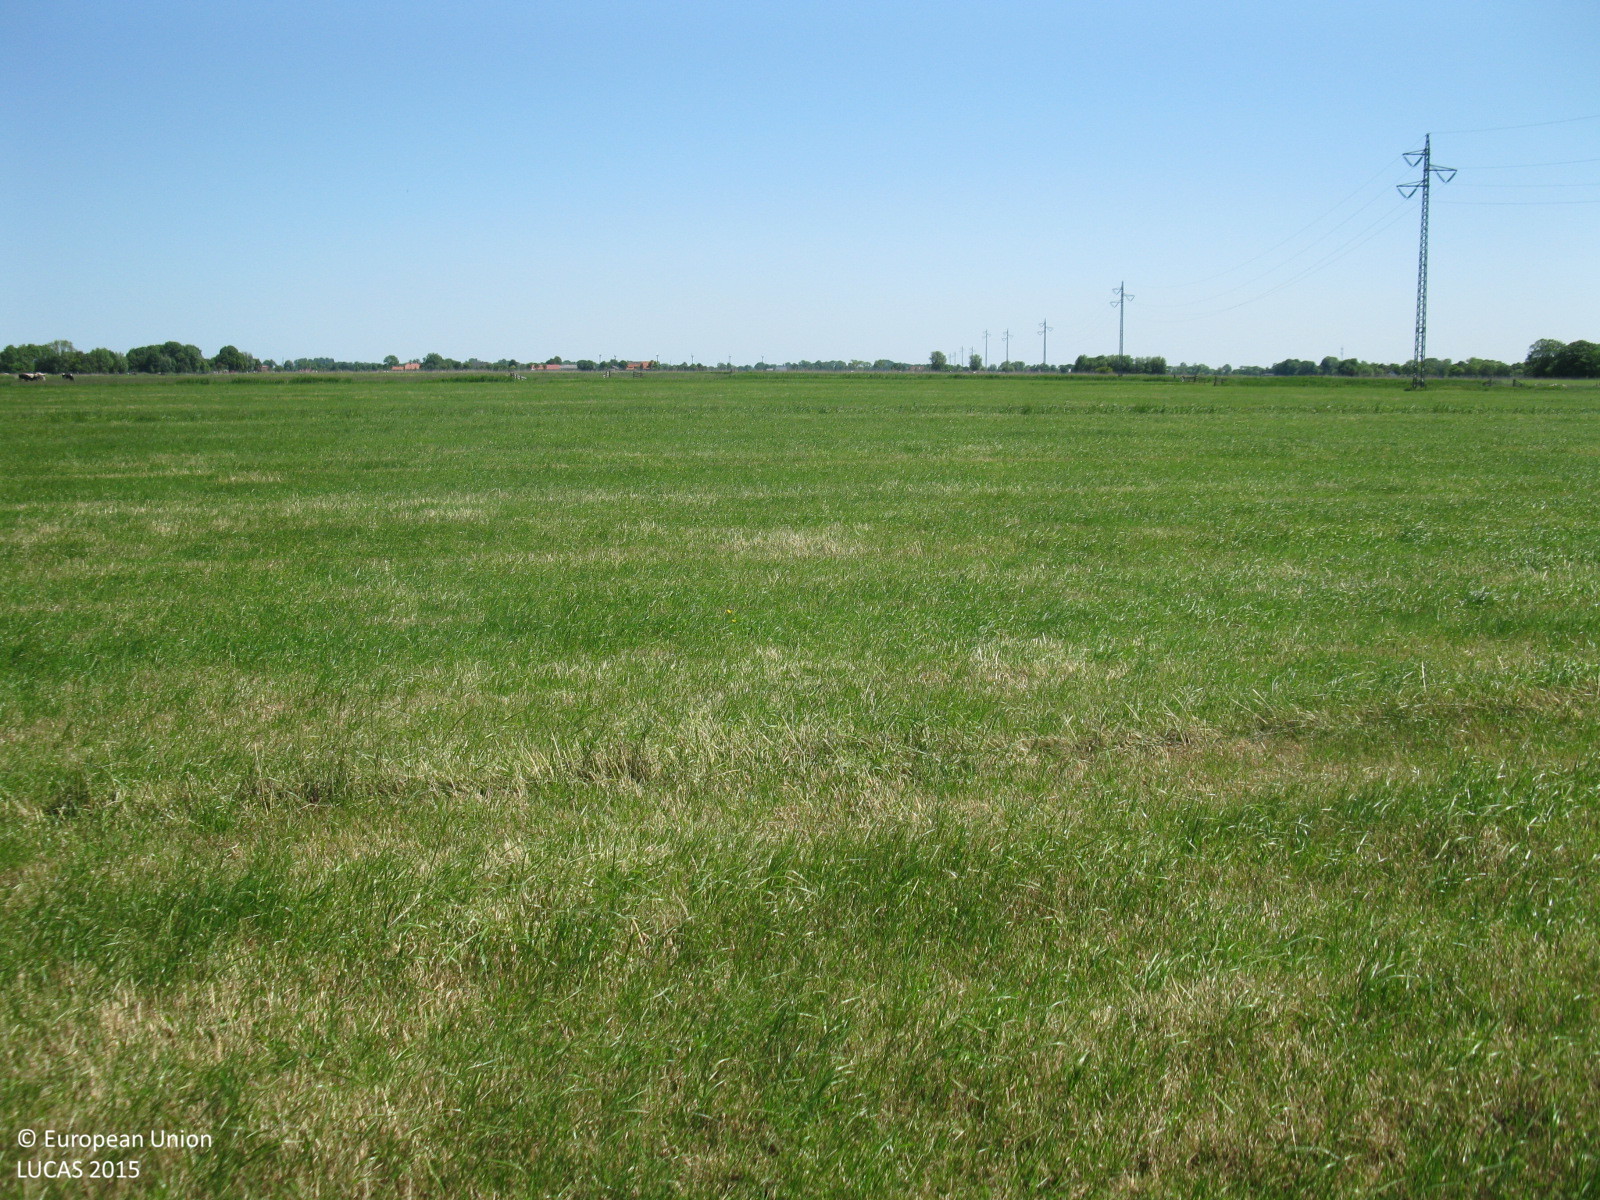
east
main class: Grassland
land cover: Grassland without tree/shrub cover
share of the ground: > 75 %
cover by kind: herbaceous plants 100 %
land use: Agriculture (excluding fallow land and kitchen gardens)
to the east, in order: Grassland without tree/shrub cover; Ditches and canals; Shrubland without tree cover; Ditches and canals; Grassland without tree/shrub cover
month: June
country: DE
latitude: 53.5521
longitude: 8.3253
